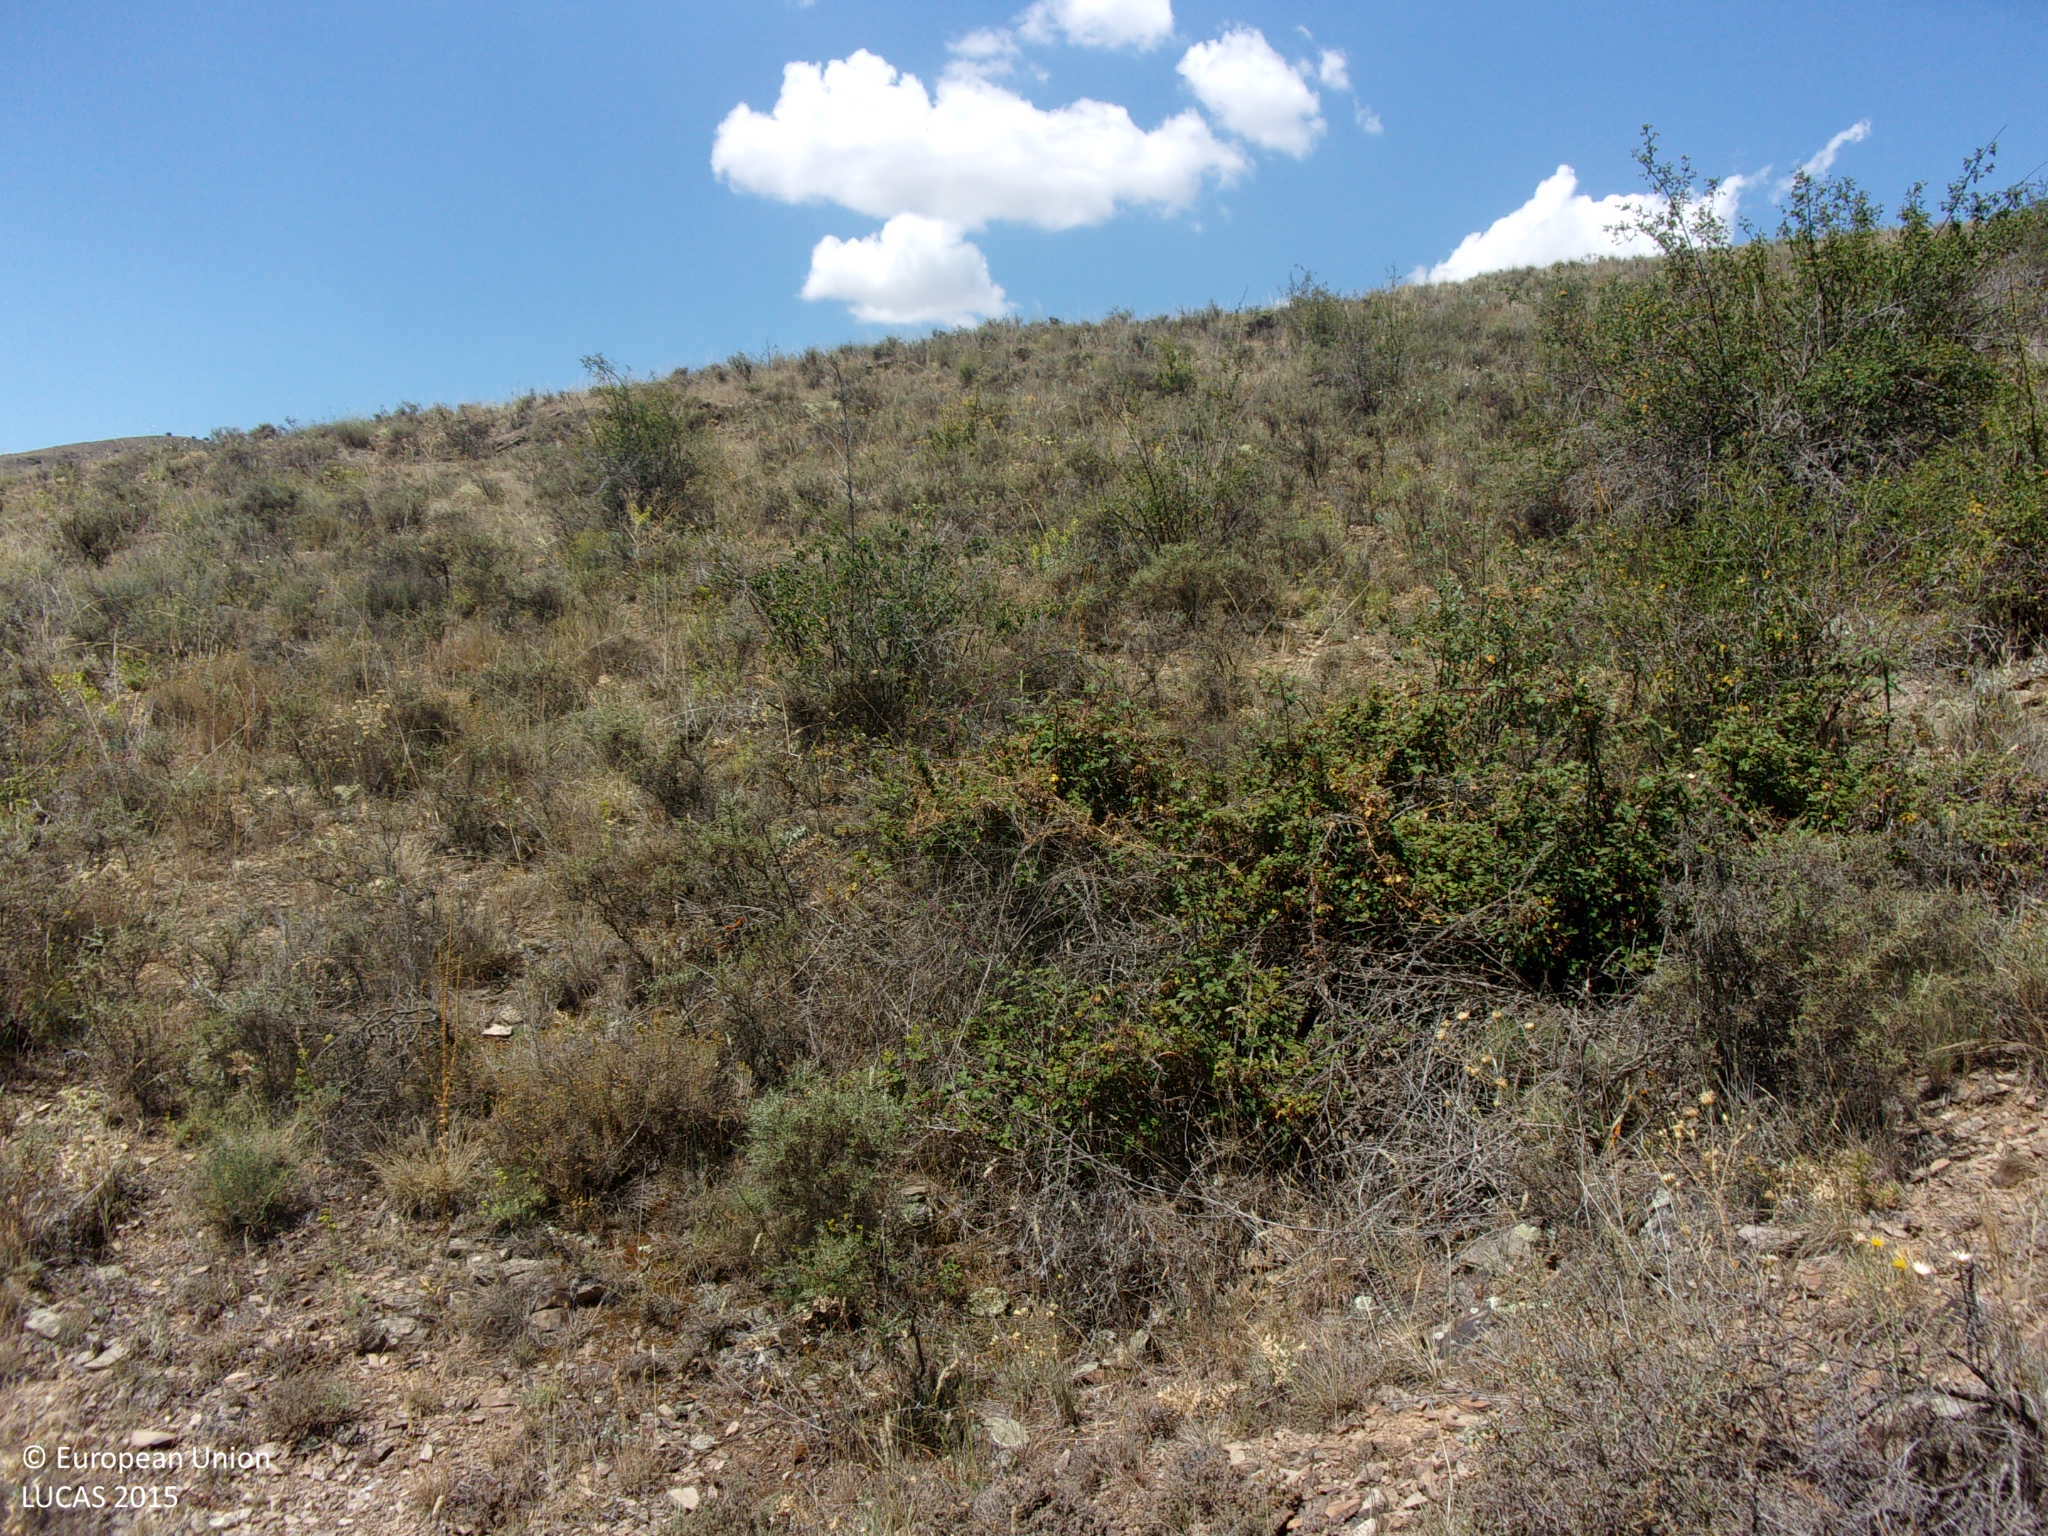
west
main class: Shrubland
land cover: Shrubland without tree cover
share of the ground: > 75 %
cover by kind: shrubs 80 %, herbaceous plants 10 %, consolidated bare surface 10 %
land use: Semi-natural and natural areas not in use
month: July
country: ES
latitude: 41.0112
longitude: -1.3510
